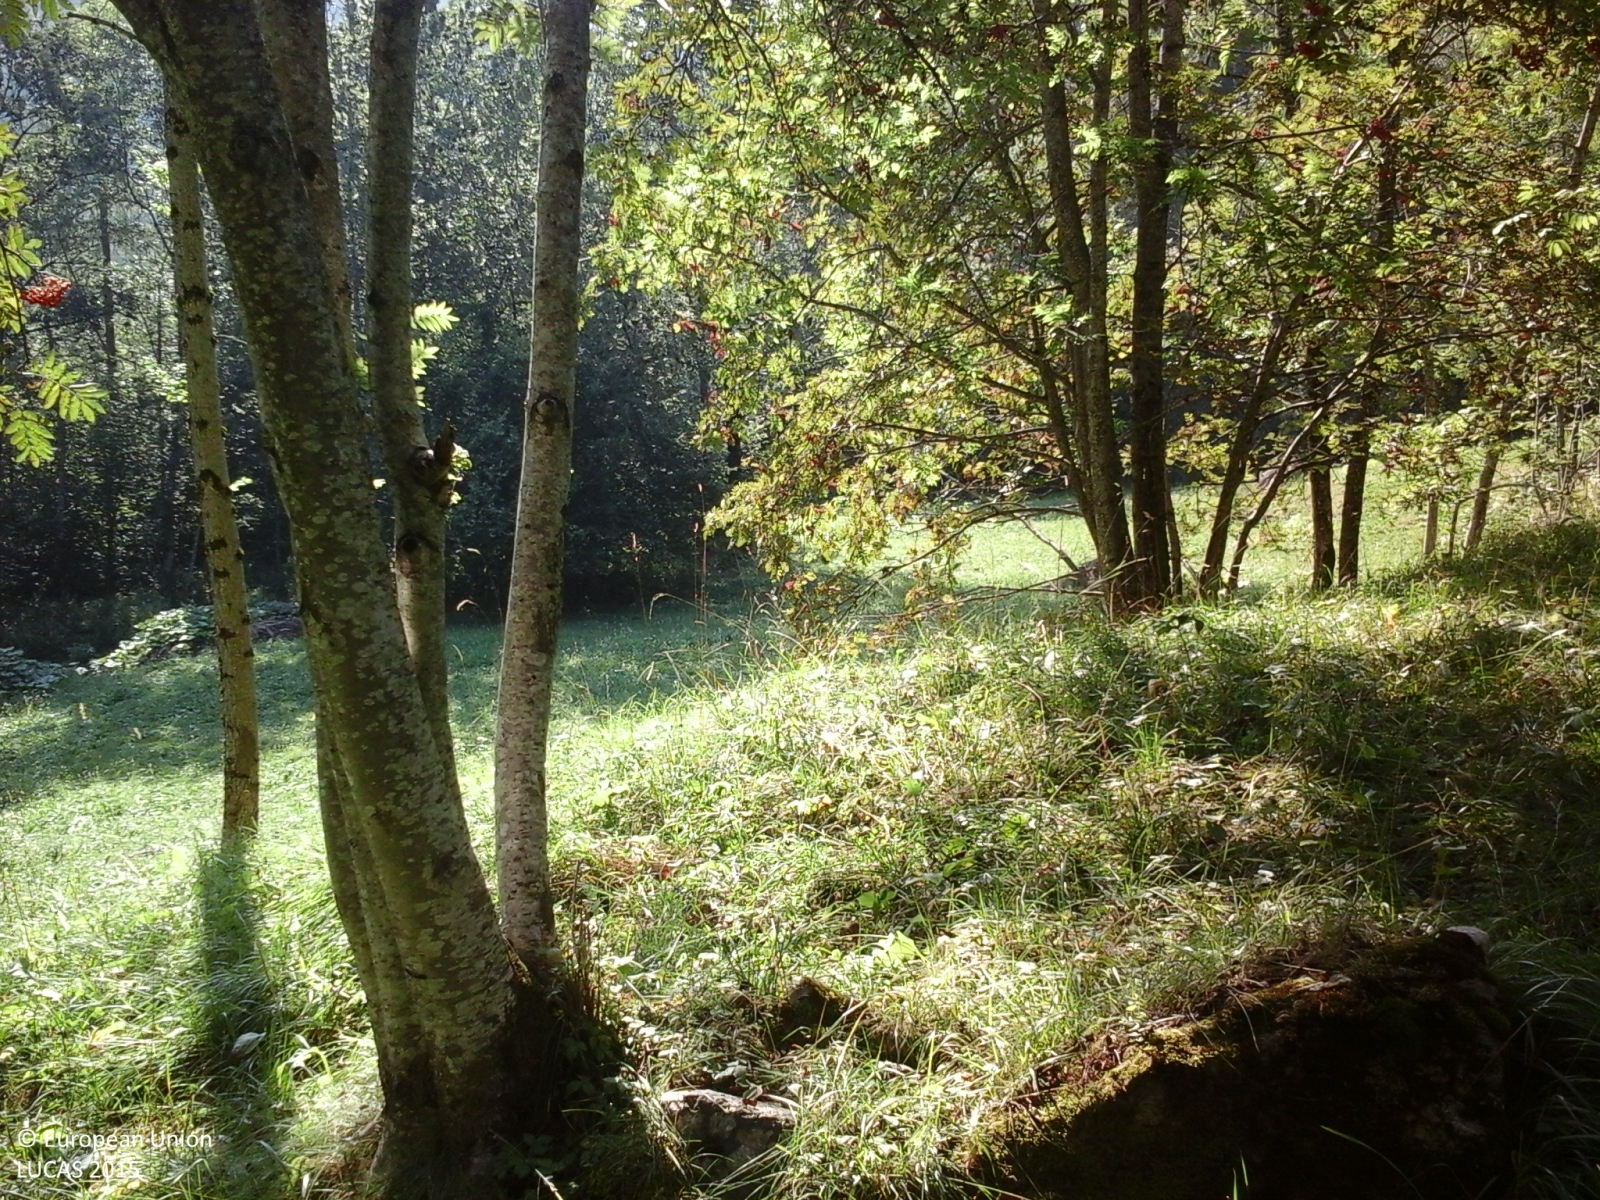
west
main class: Woodland
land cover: Broadleaved woodland
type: thermophilous deciduous forest
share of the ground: > 75 %
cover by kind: broadleaved forest trees 70 %, herbaceous plants 20 %, shrubs 10 %
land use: Forestry
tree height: > 5 m
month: August
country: IT
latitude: 45.6221
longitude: 7.6308
